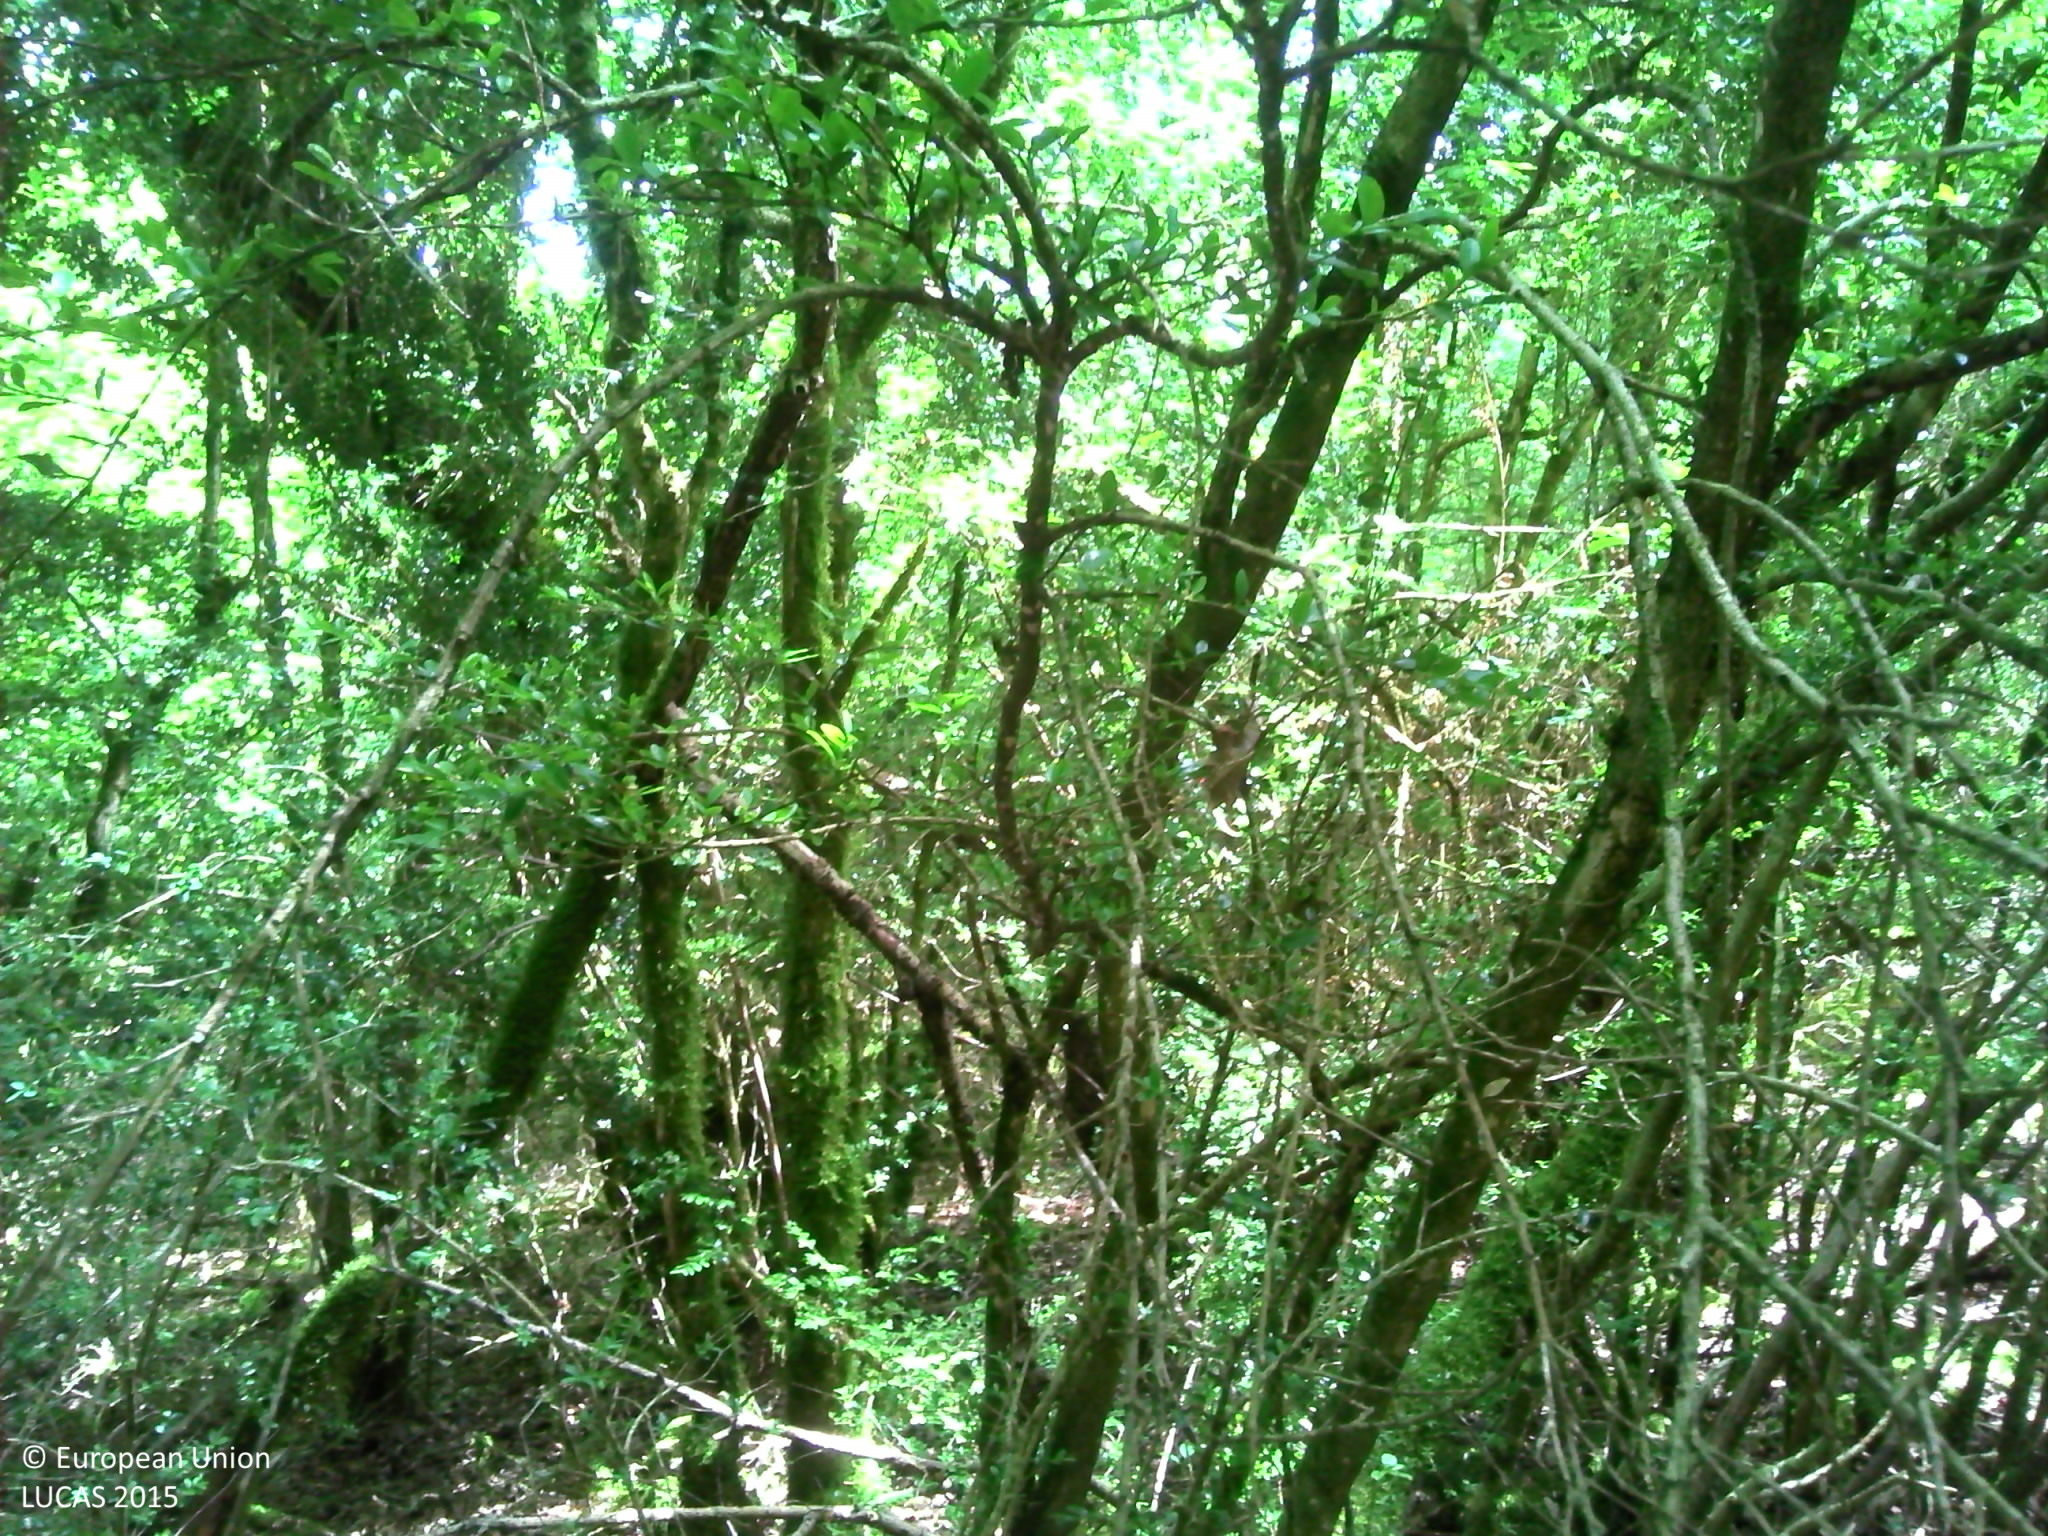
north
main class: Woodland
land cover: Broadleaved woodland
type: acidophilous oak and oak-birch forest
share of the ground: > 75 %
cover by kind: broadleaved forest trees 75 %, shrubs 10 %, herbaceous plants 10 %, lichens and mosses 5 %
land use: Agriculture (excluding fallow land and kitchen gardens)
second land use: Forestry
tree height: > 5 m
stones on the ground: > 50 %
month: June
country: FR
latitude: 46.4195
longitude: 5.5140
